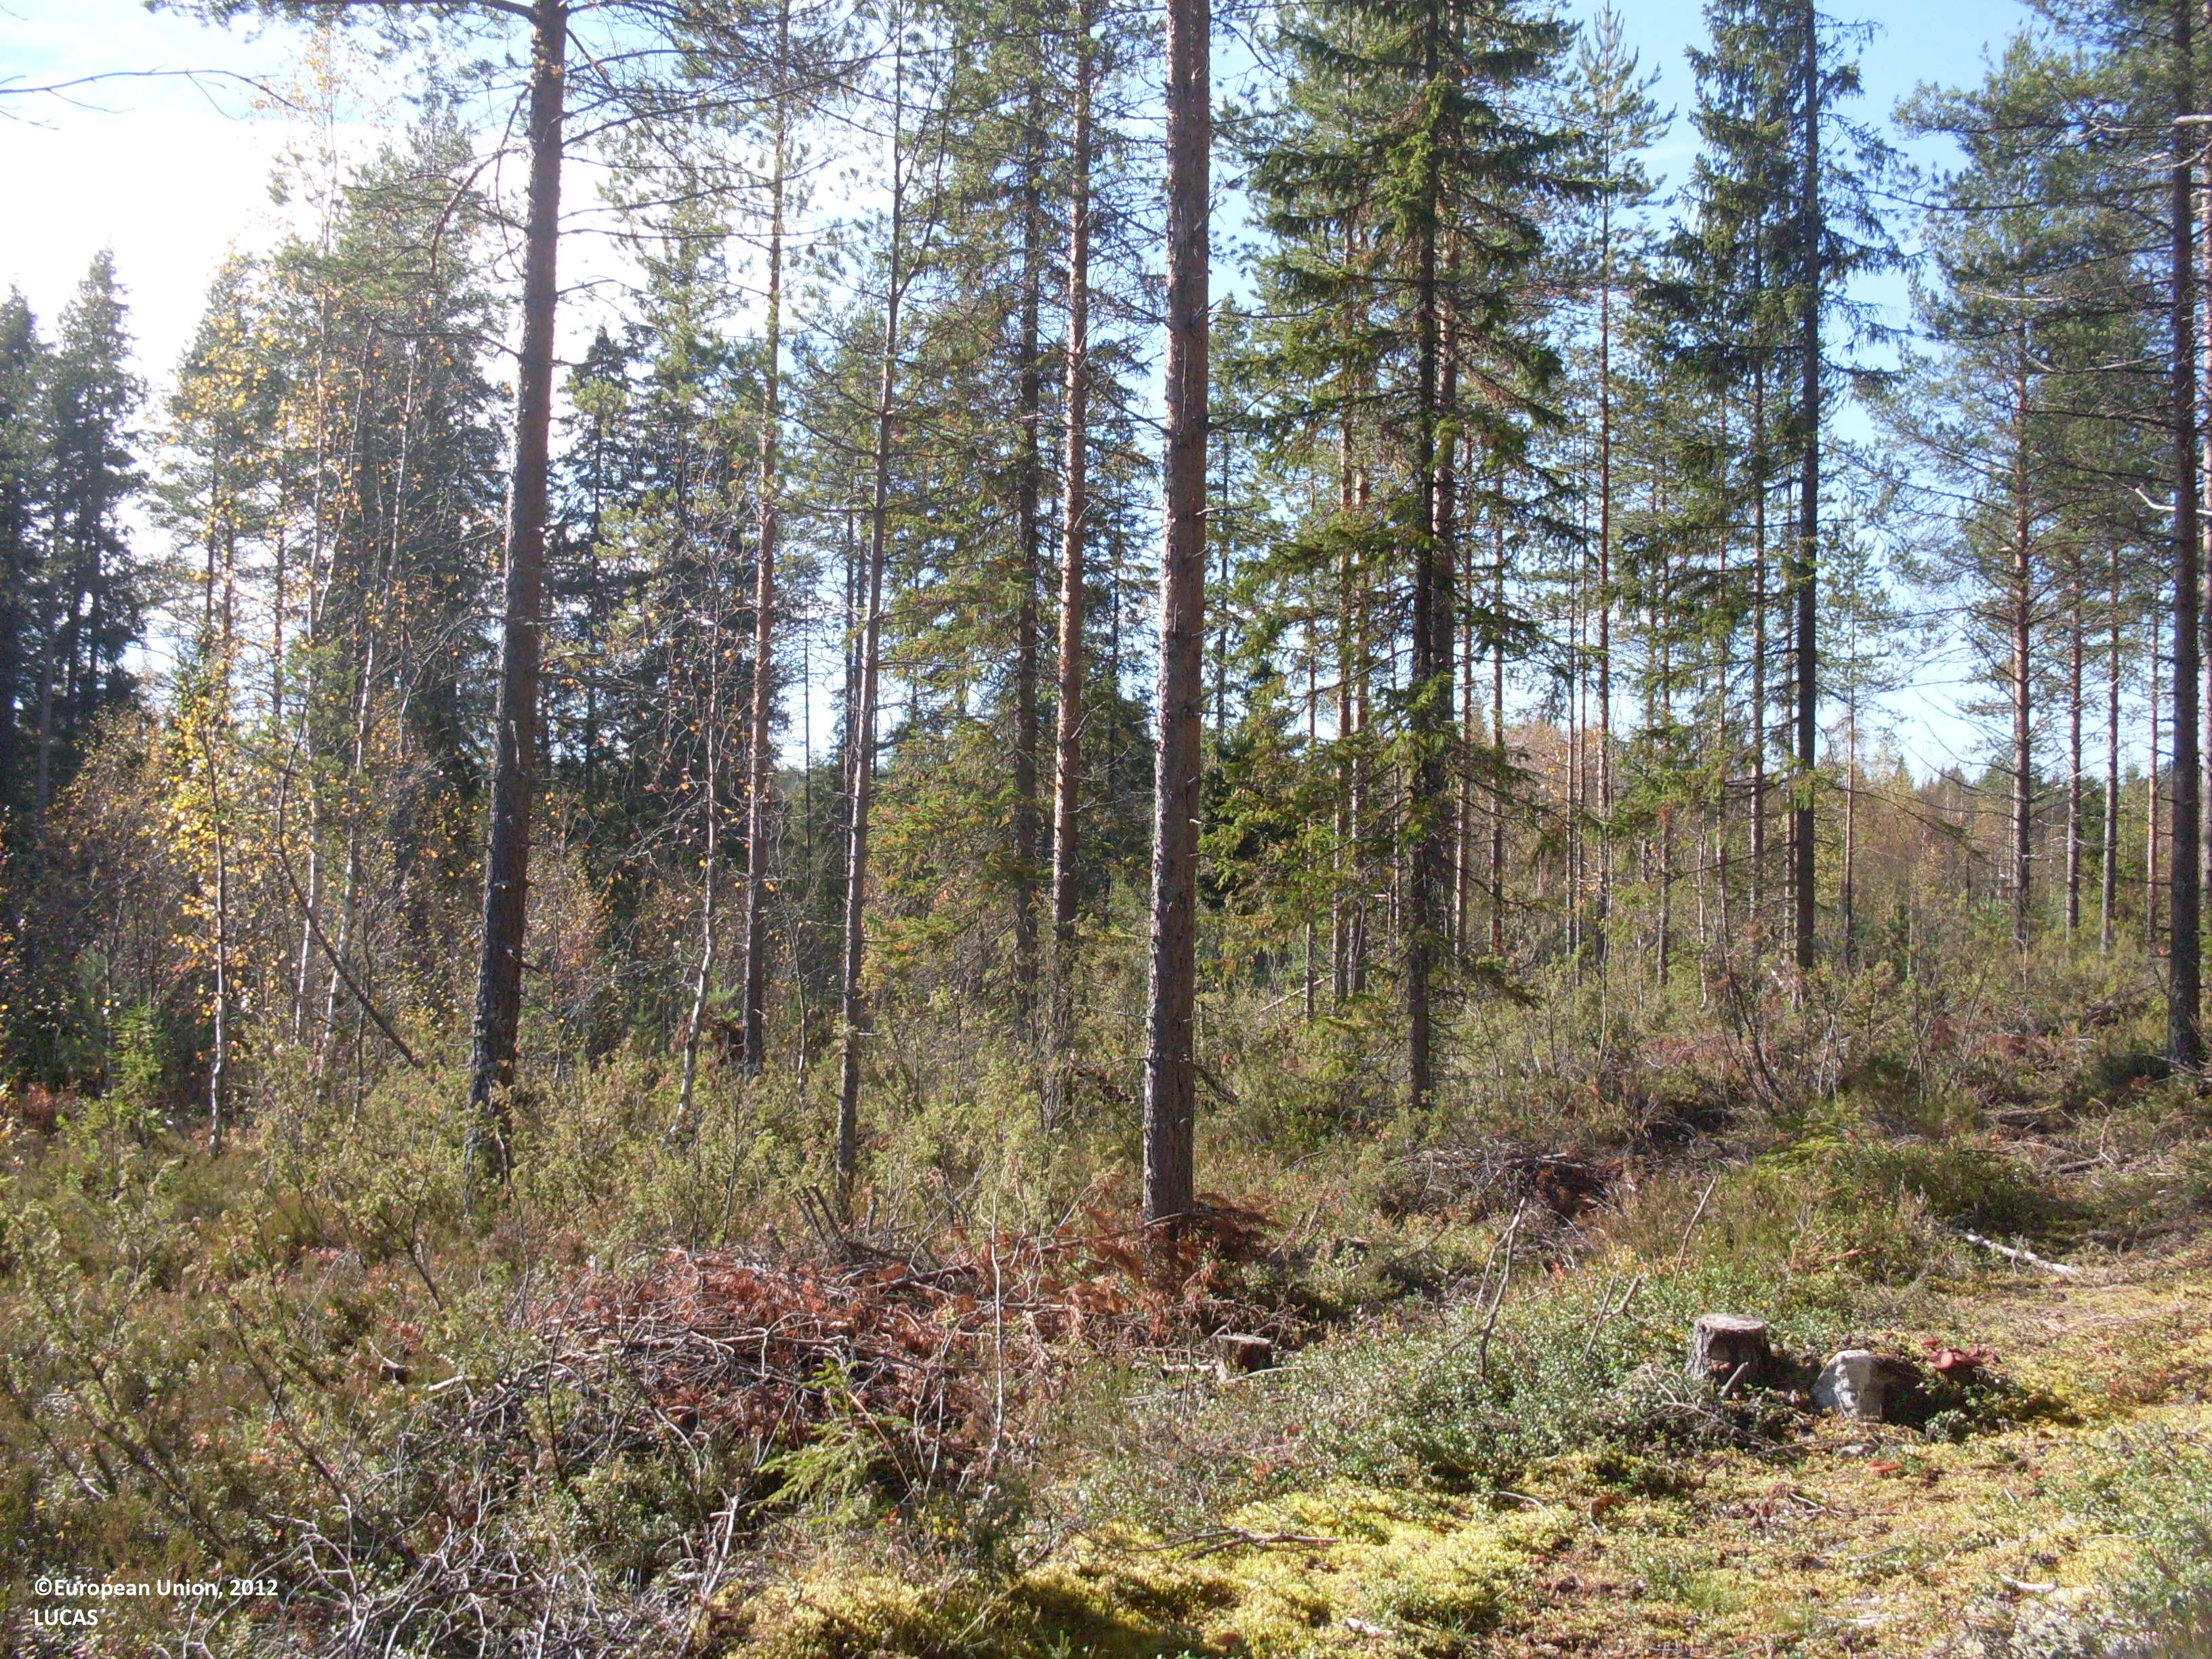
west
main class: Woodland
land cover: Pine dominated mixed woodland
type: boreal forest
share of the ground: > 75 %
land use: Forestry
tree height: > 5 m
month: September
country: FI
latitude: 64.3656
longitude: 28.5986
